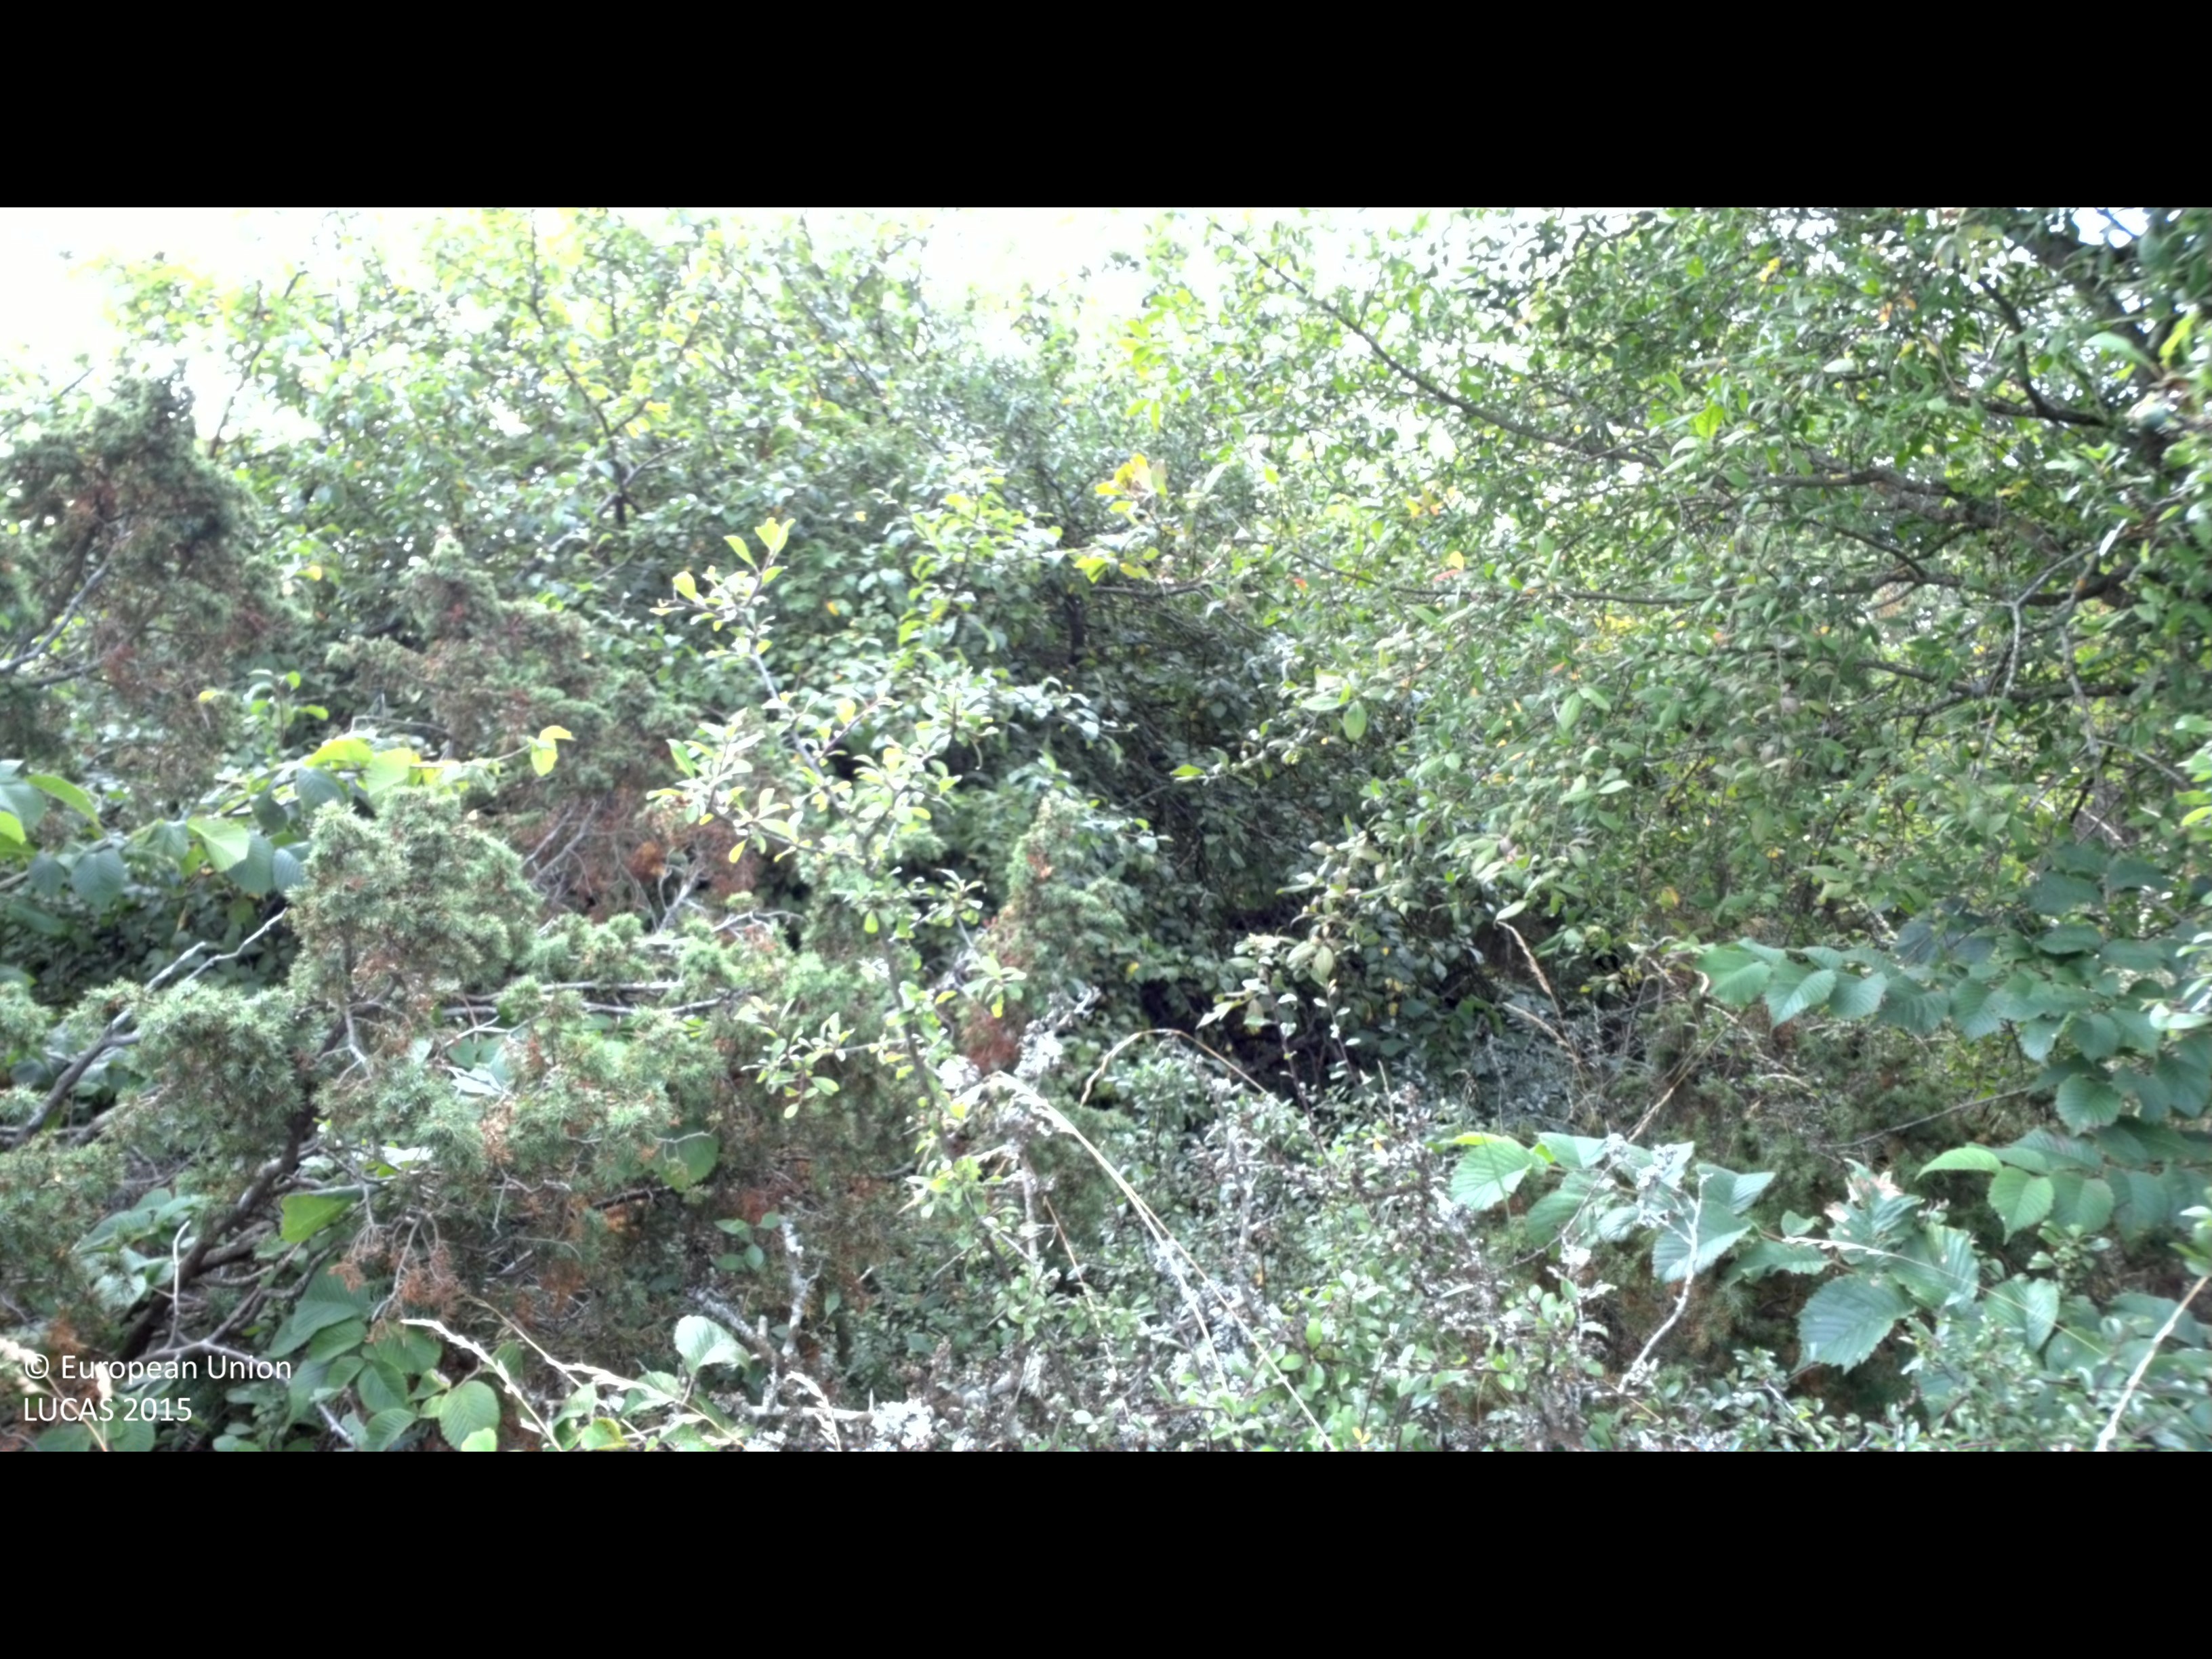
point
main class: Shrubland
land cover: Shrubland with sparse tree cover
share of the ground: > 75 %
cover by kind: shrubs 90 %, broadleaved forest trees 5 %, herbaceous plants 5 %
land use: Semi-natural and natural areas not in use
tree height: < 5 m
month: July
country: SE
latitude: 56.8459
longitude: 16.6414
